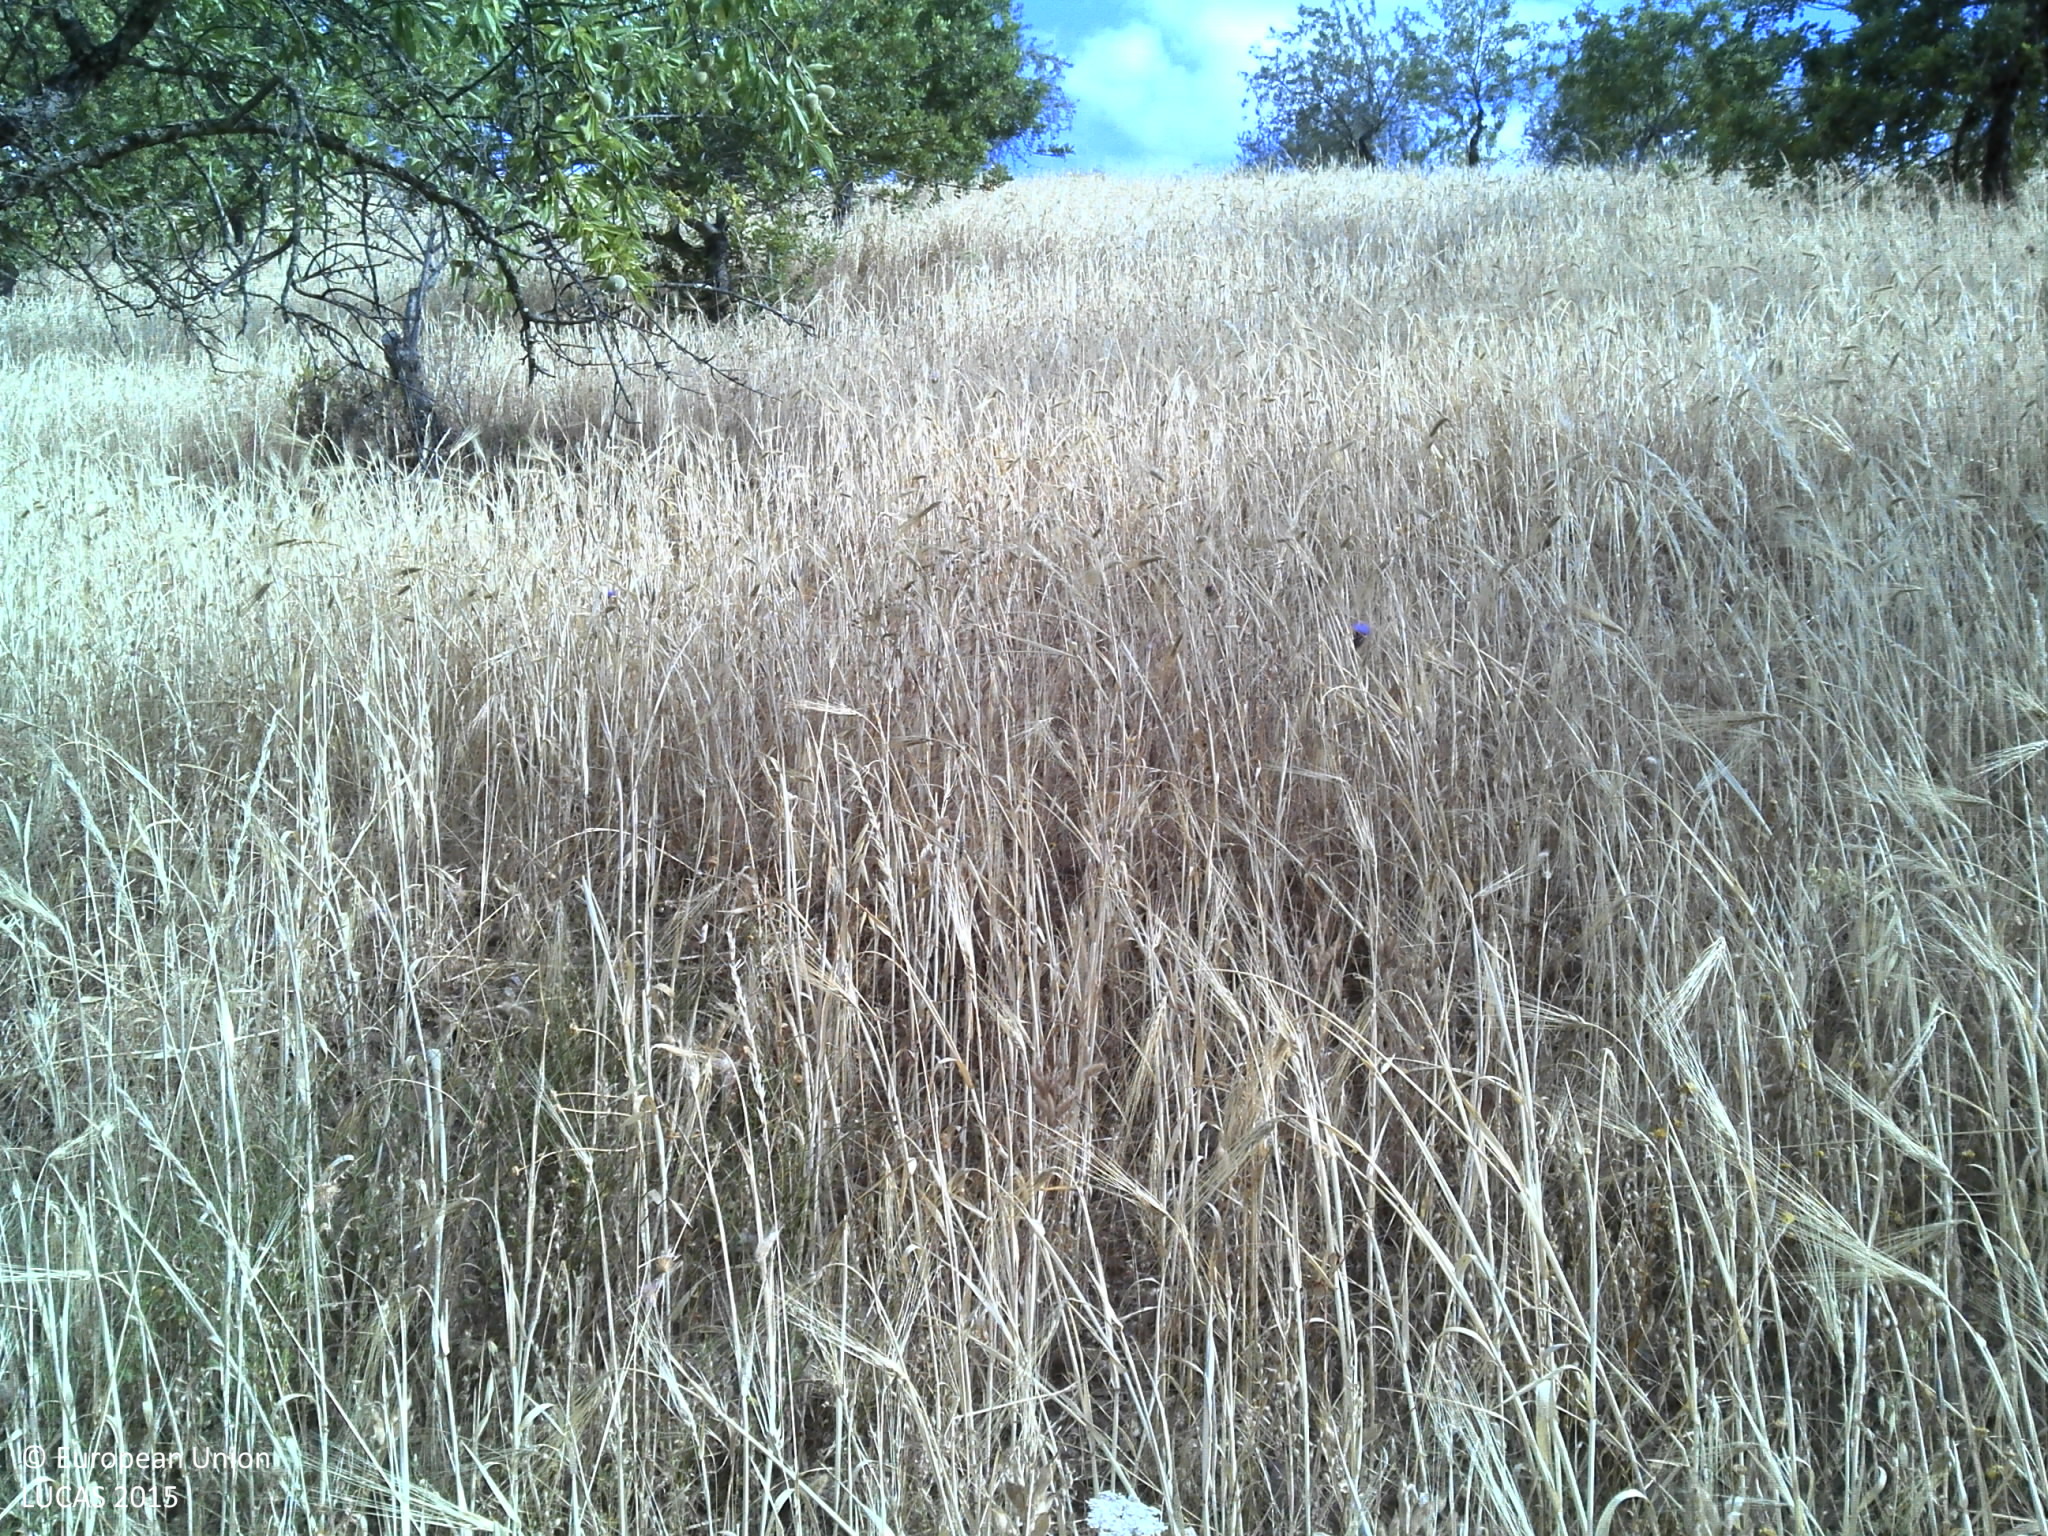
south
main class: Cropland
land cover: Nuts trees
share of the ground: 25 - 50 %
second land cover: Barley
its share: > 75 %
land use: Agriculture (excluding fallow land and kitchen gardens)
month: June
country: PT
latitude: 37.3277
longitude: -7.7176
